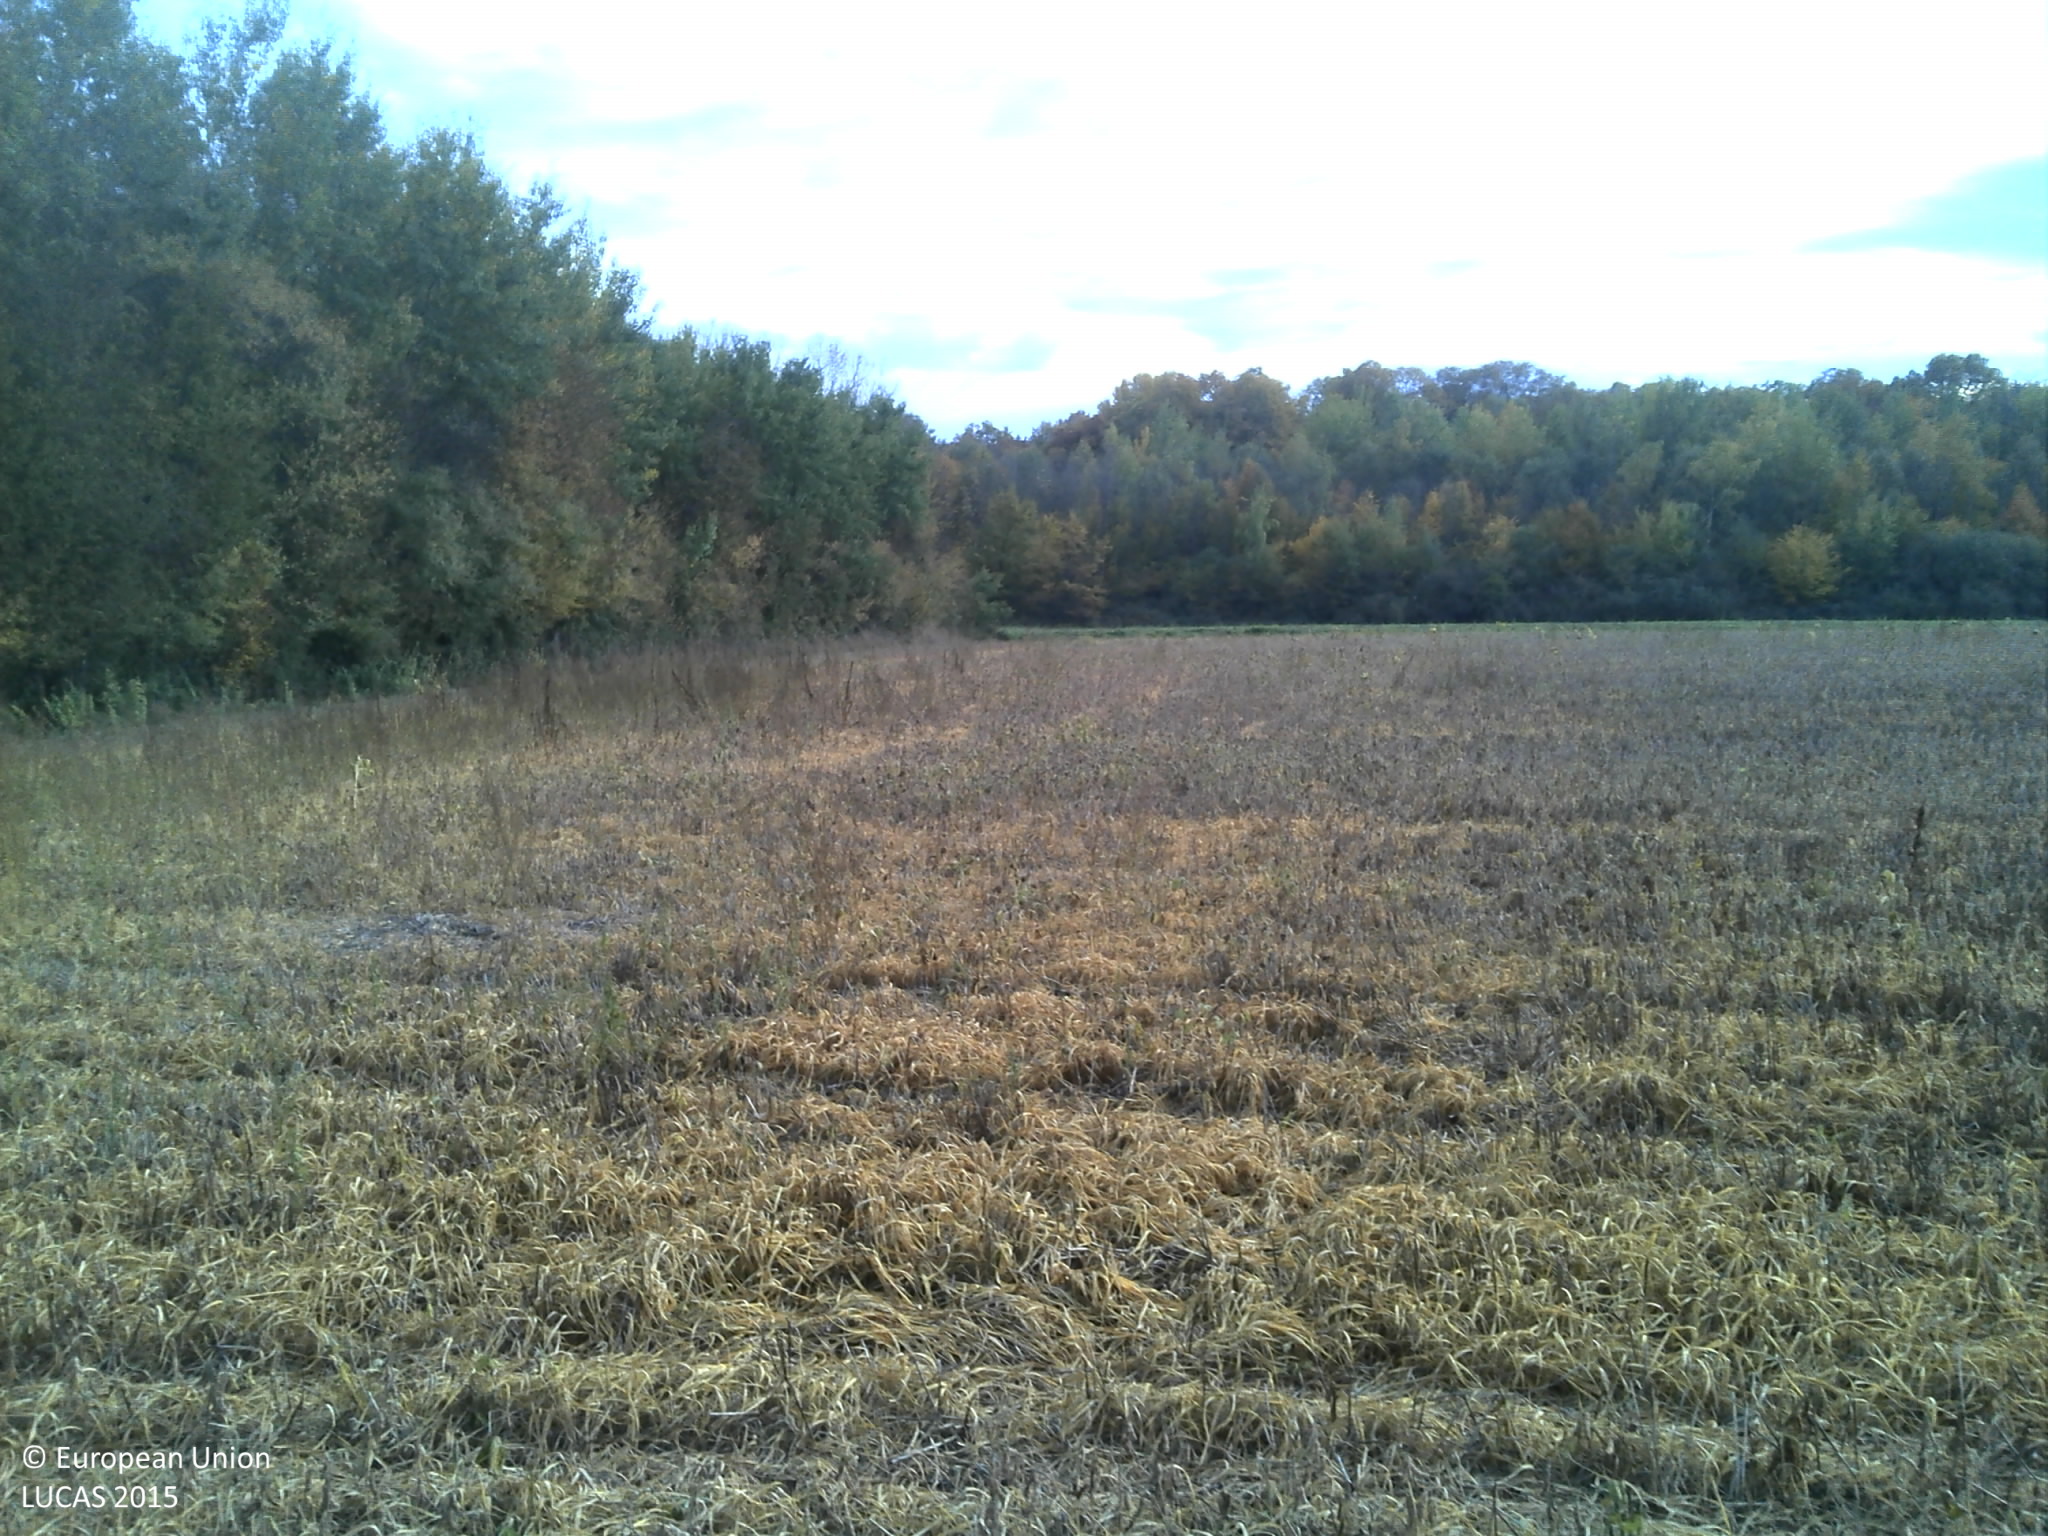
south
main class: Cropland
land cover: Common wheat
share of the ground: 50 - 75 %
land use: Agriculture (excluding fallow land and kitchen gardens)
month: October
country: FR
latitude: 47.0776
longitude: 5.2996
